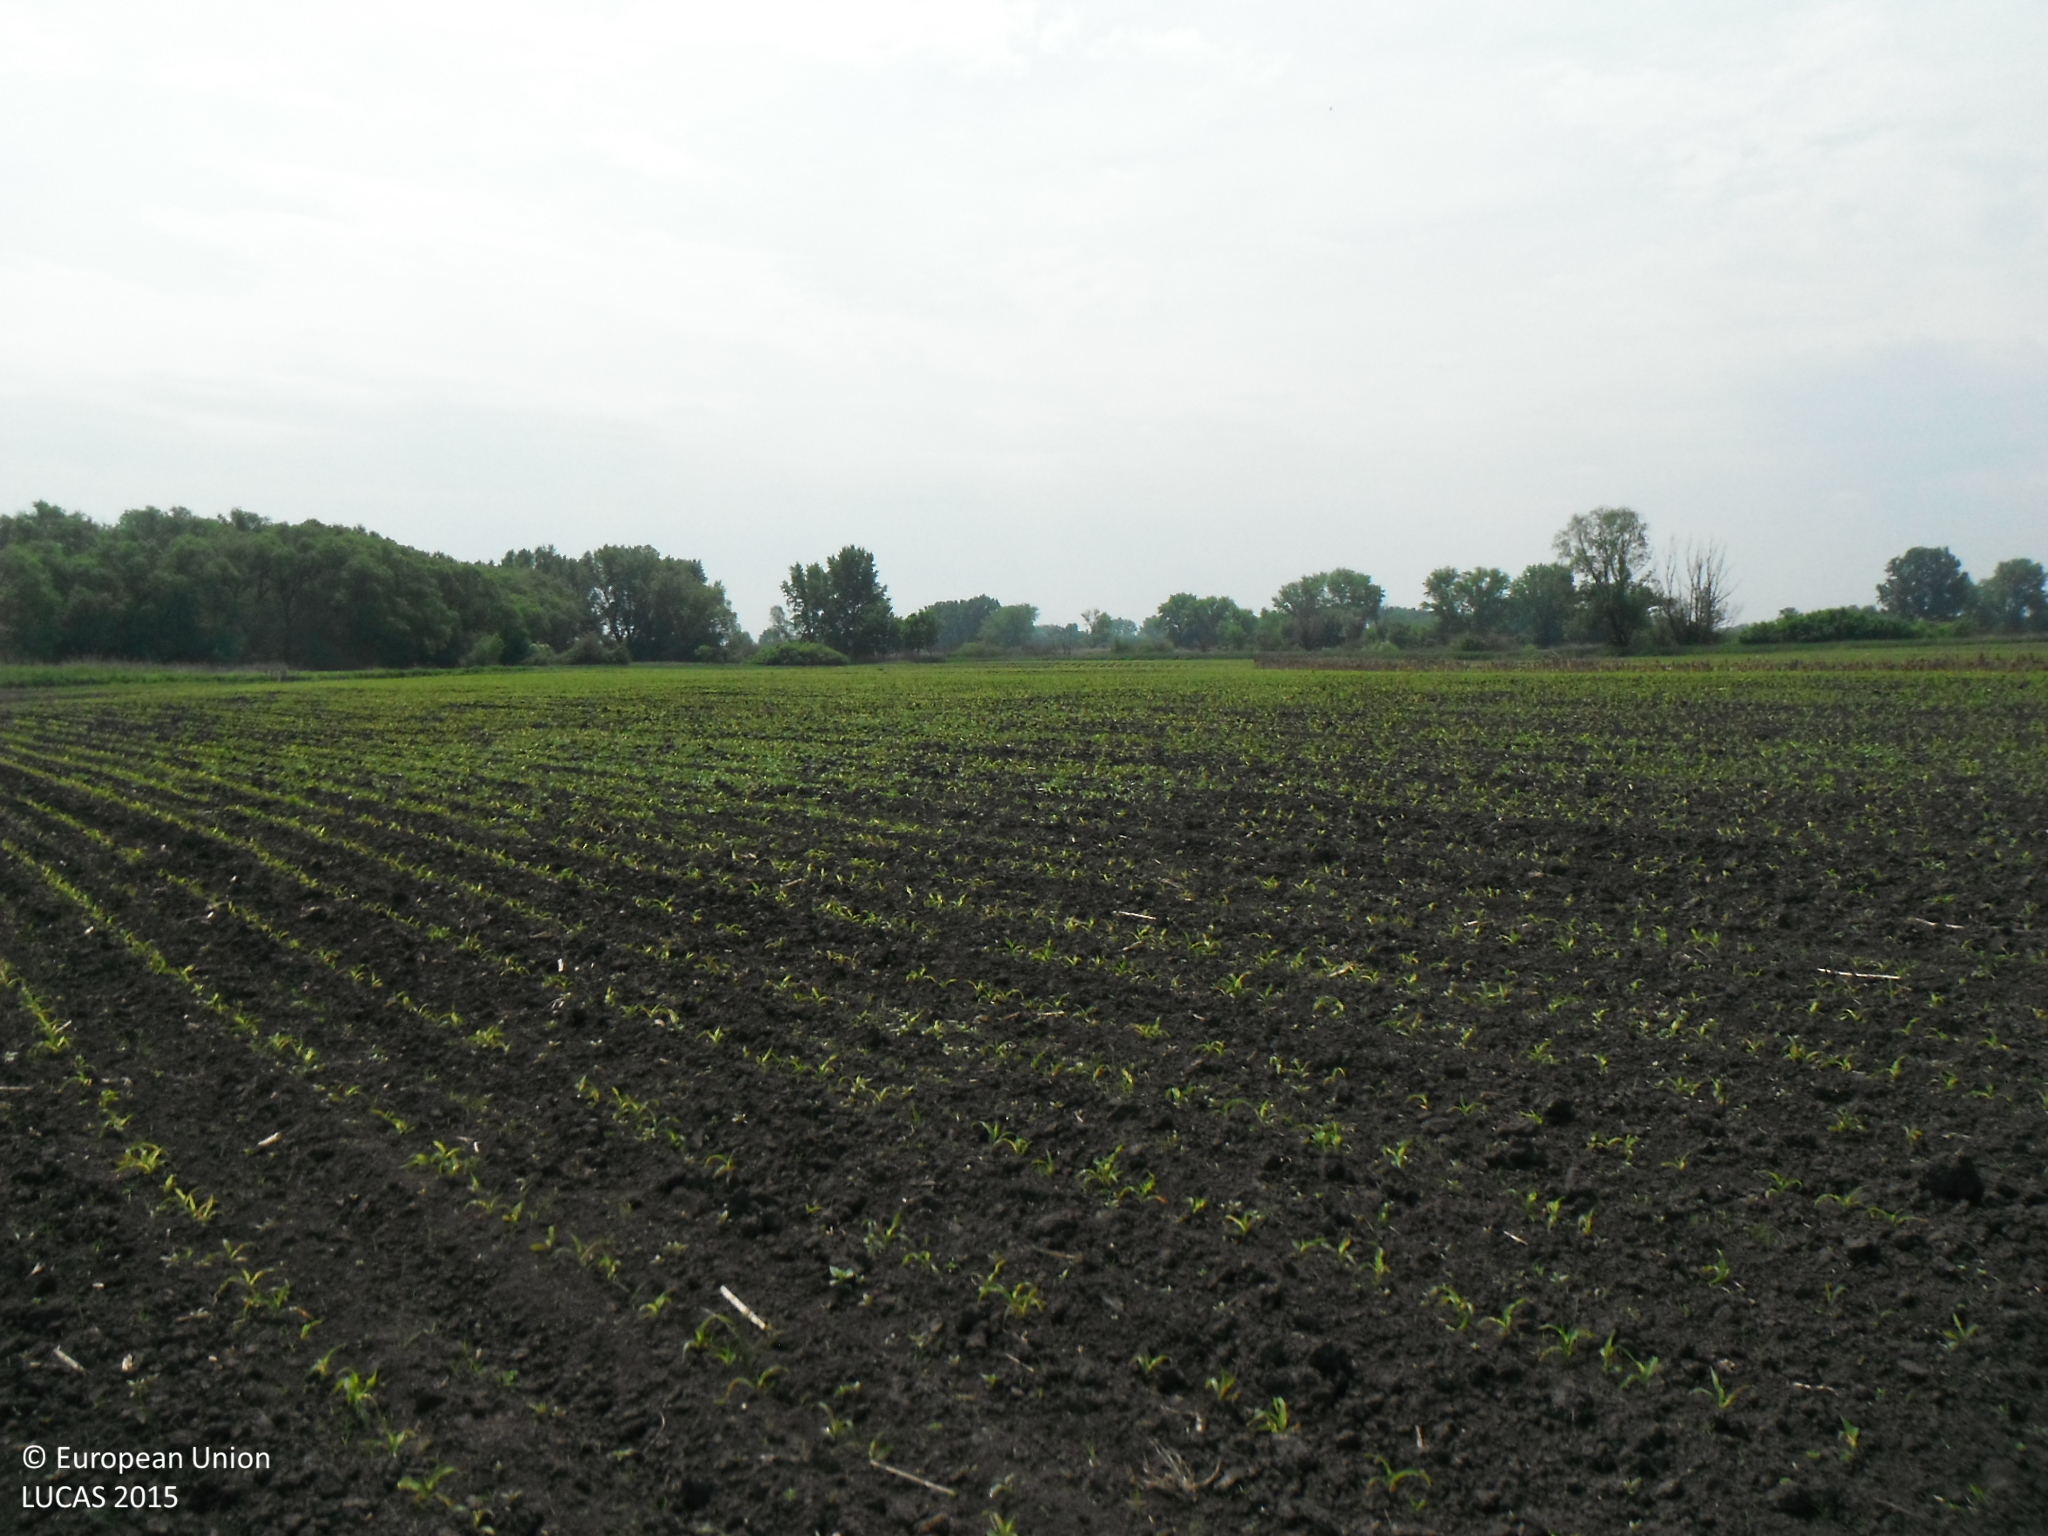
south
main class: Cropland
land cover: Maize
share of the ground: < 10 %
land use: Agriculture (excluding fallow land and kitchen gardens)
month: May
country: SK
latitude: 47.9392
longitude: 17.6540
